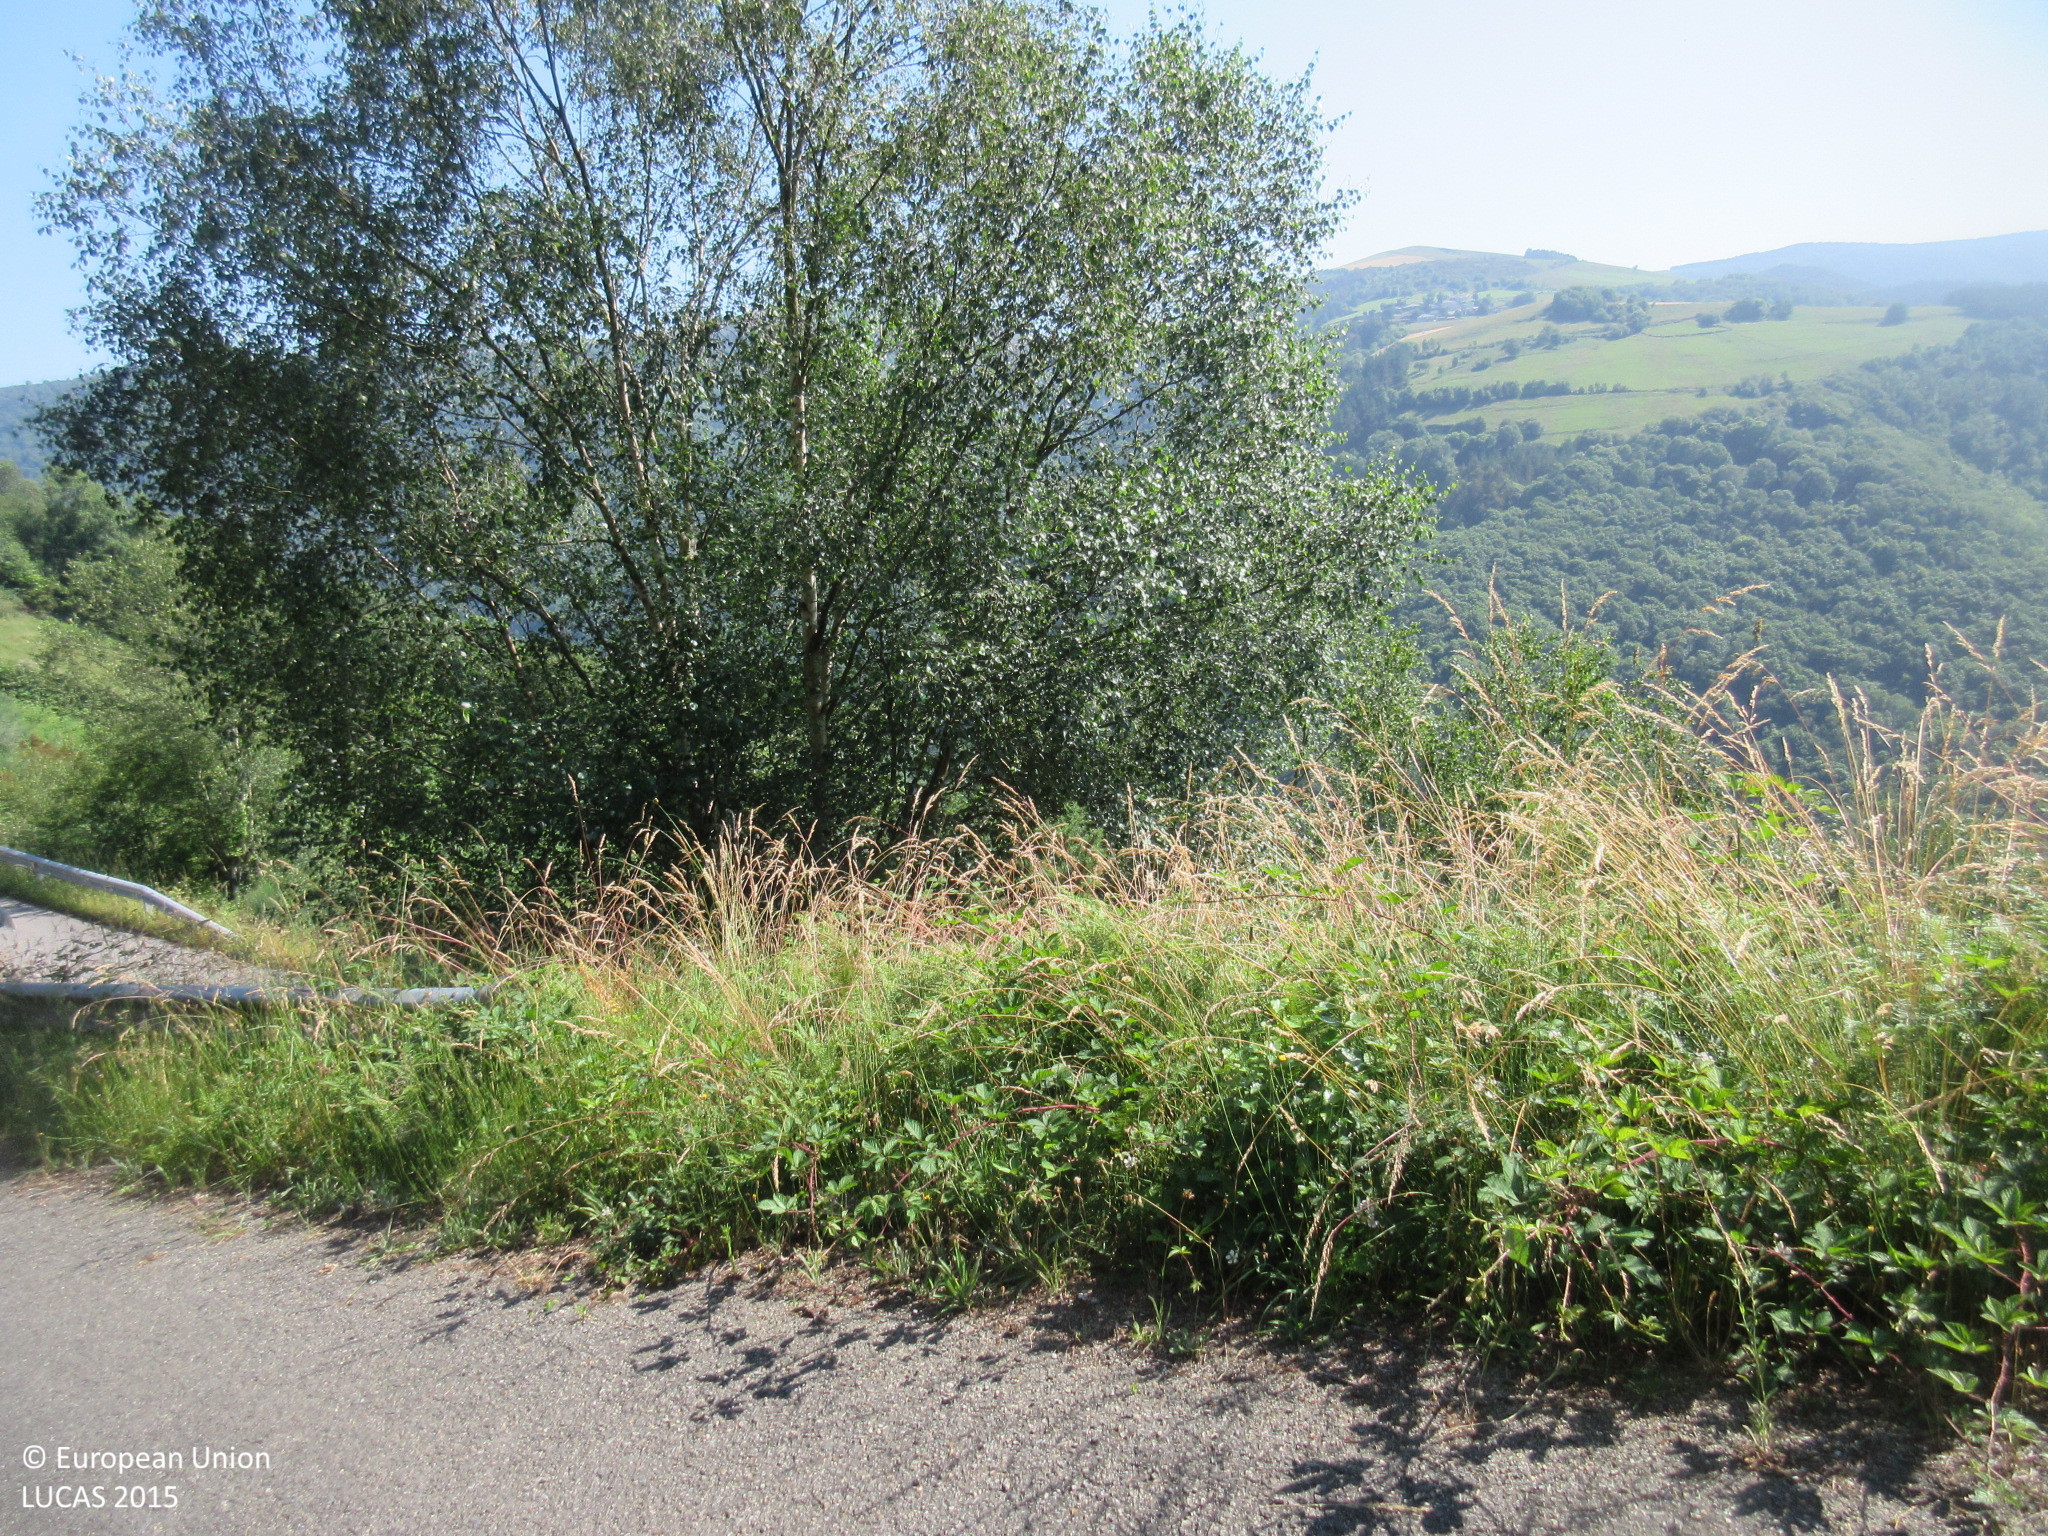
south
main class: Shrubland
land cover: Shrubland with sparse tree cover
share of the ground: > 75 %
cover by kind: shrubs 95 %, broadleaved forest trees 5 %
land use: Forestry
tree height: > 5 m
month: June
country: ES
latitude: 43.3275
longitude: -7.0743
